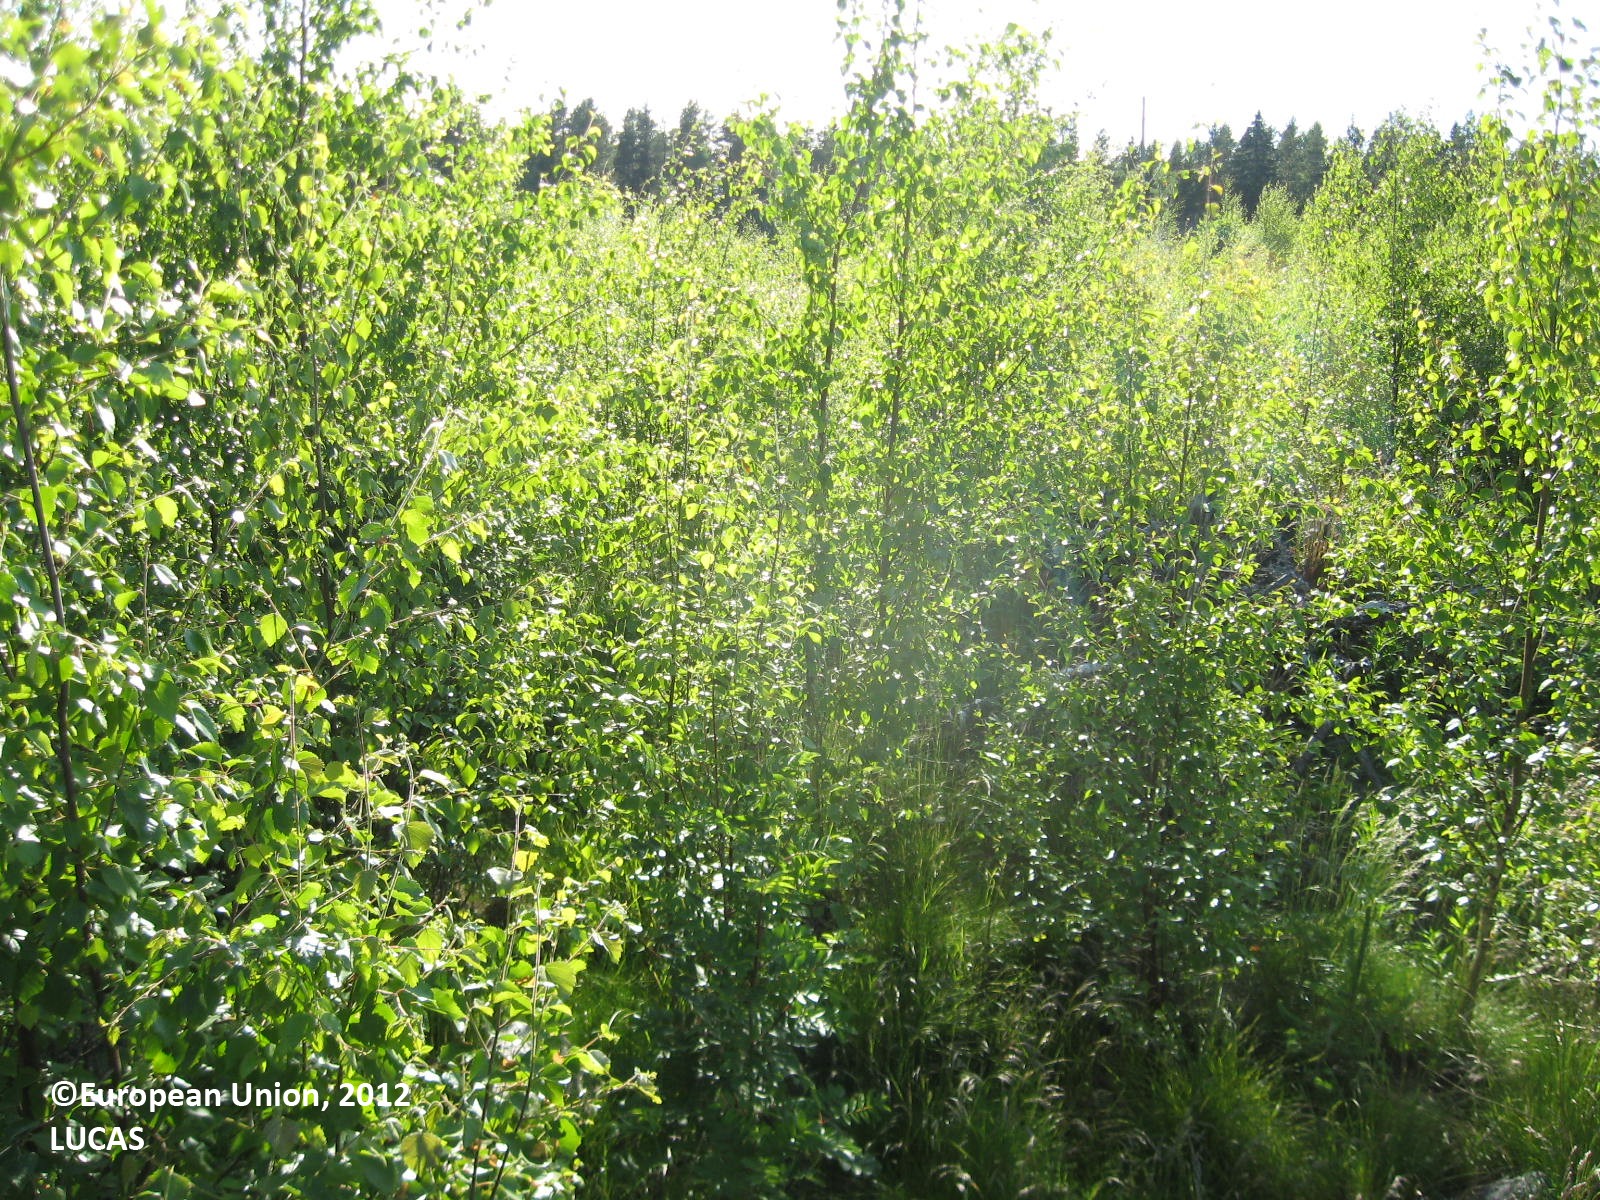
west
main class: Woodland
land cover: Broadleaved woodland
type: boreal forest
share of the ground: > 75 %
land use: Forestry
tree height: < 5 m
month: June
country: FI
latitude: 62.6189
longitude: 21.6012
